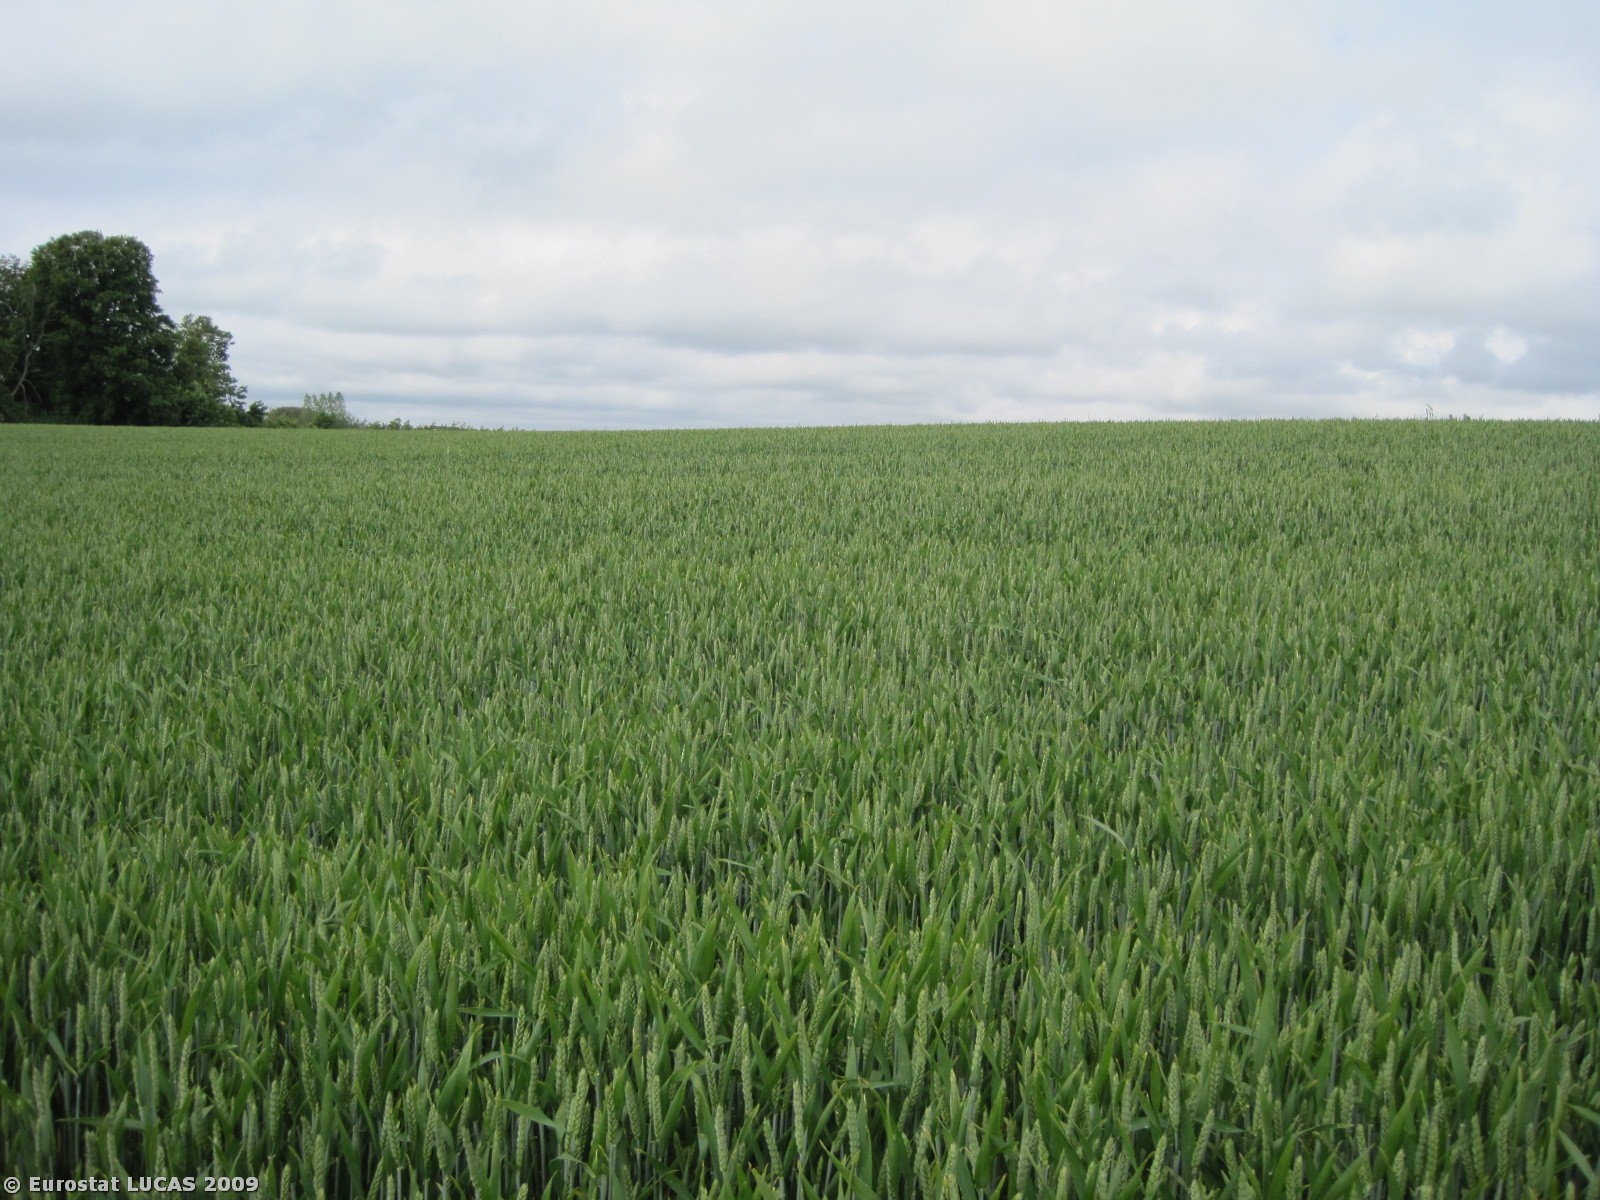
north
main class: Cropland
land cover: Common wheat
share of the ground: > 75 %
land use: Agriculture (excluding fallow land and kitchen gardens)
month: June
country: DK
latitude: 57.3561
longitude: 10.2489
